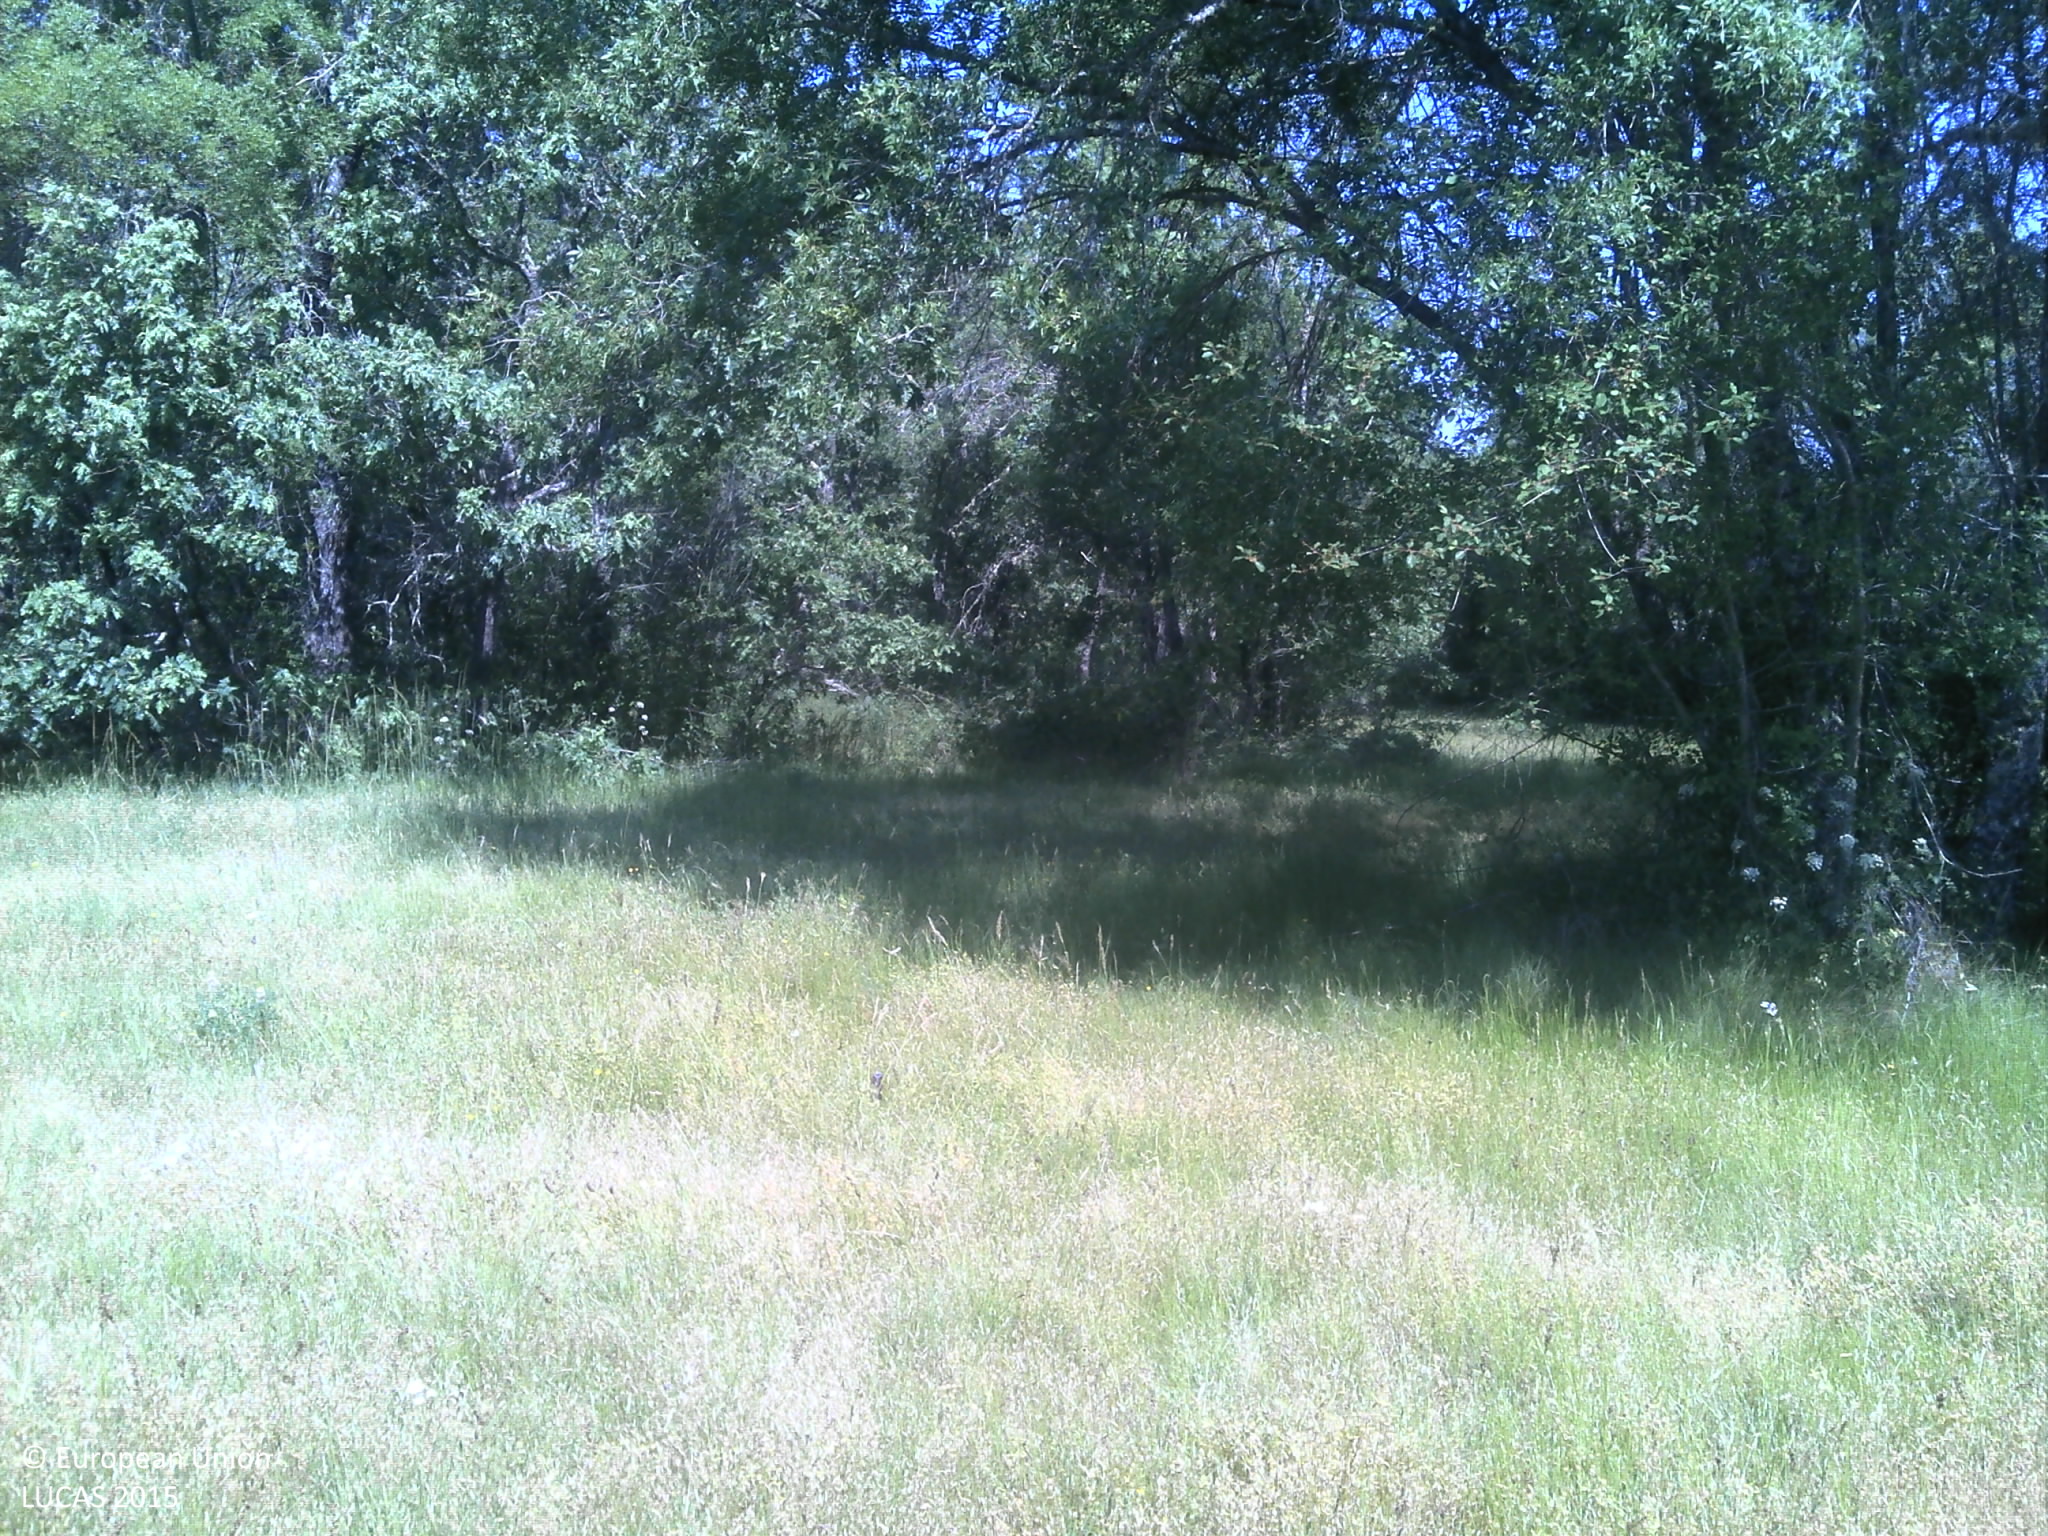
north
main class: Grassland
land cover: Grassland without tree/shrub cover
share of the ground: 50 - 75 %
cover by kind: herbaceous plants 75 %, unconsolidated bare surface 25 %
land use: Agriculture (excluding fallow land and kitchen gardens)
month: June
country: PT
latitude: 40.4136
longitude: -7.2017
